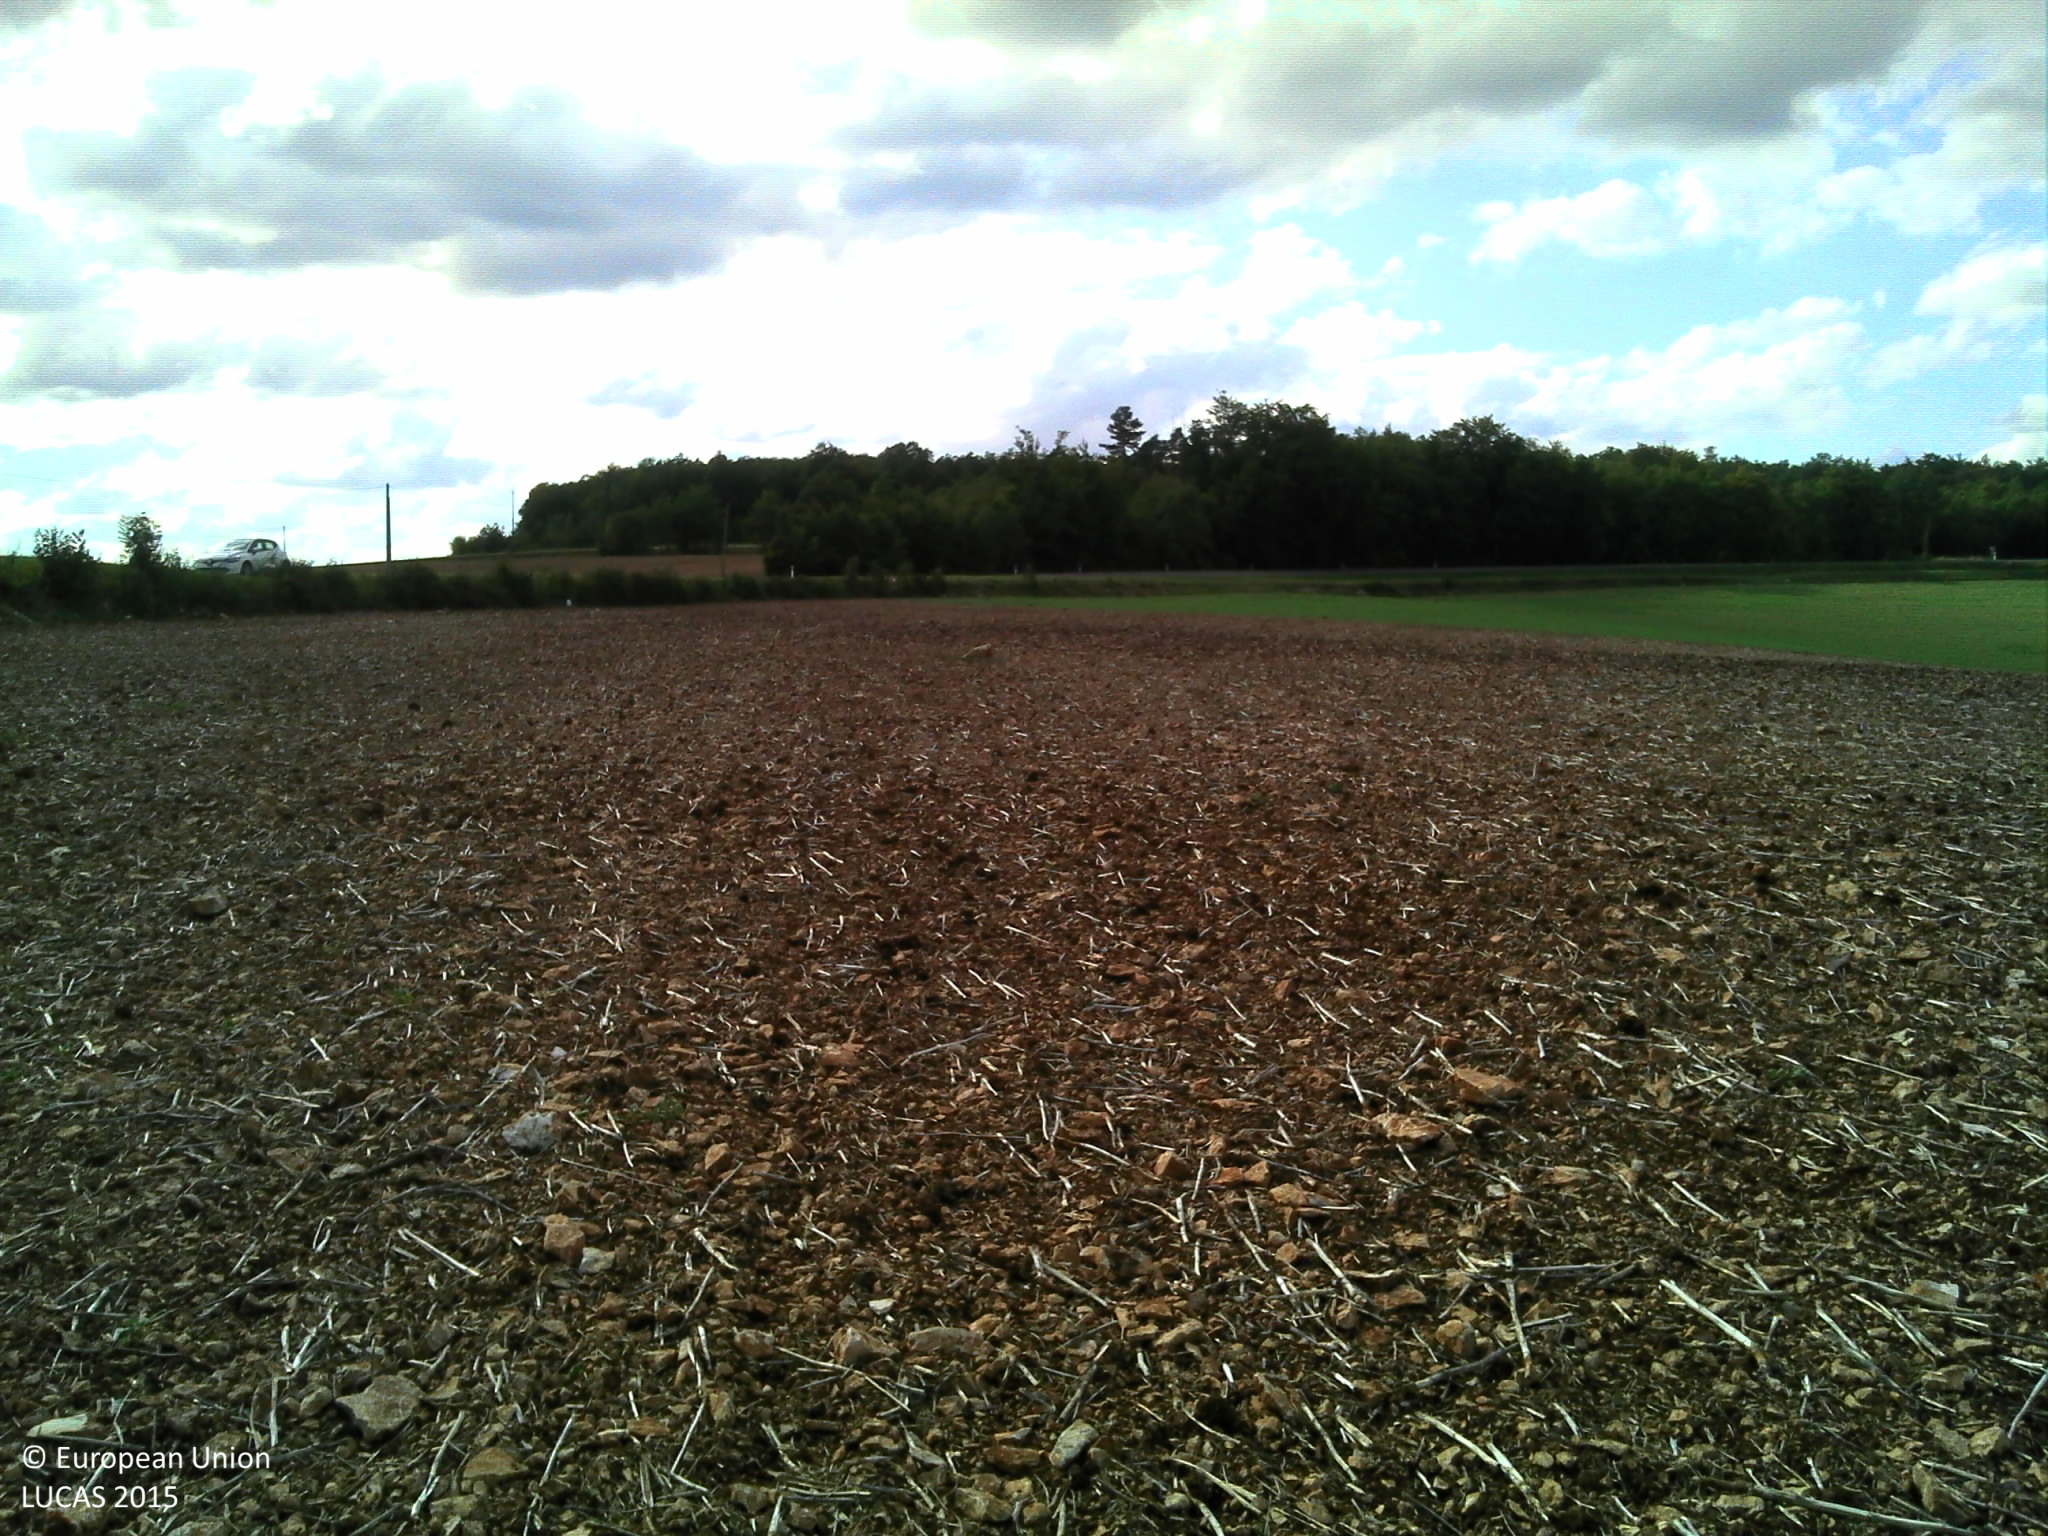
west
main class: Cropland
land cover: Rape and turnip rape
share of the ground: 25 - 50 %
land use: Agriculture (excluding fallow land and kitchen gardens)
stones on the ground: 25 - 50 %
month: September
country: FR
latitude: 47.5600
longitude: 4.8031
